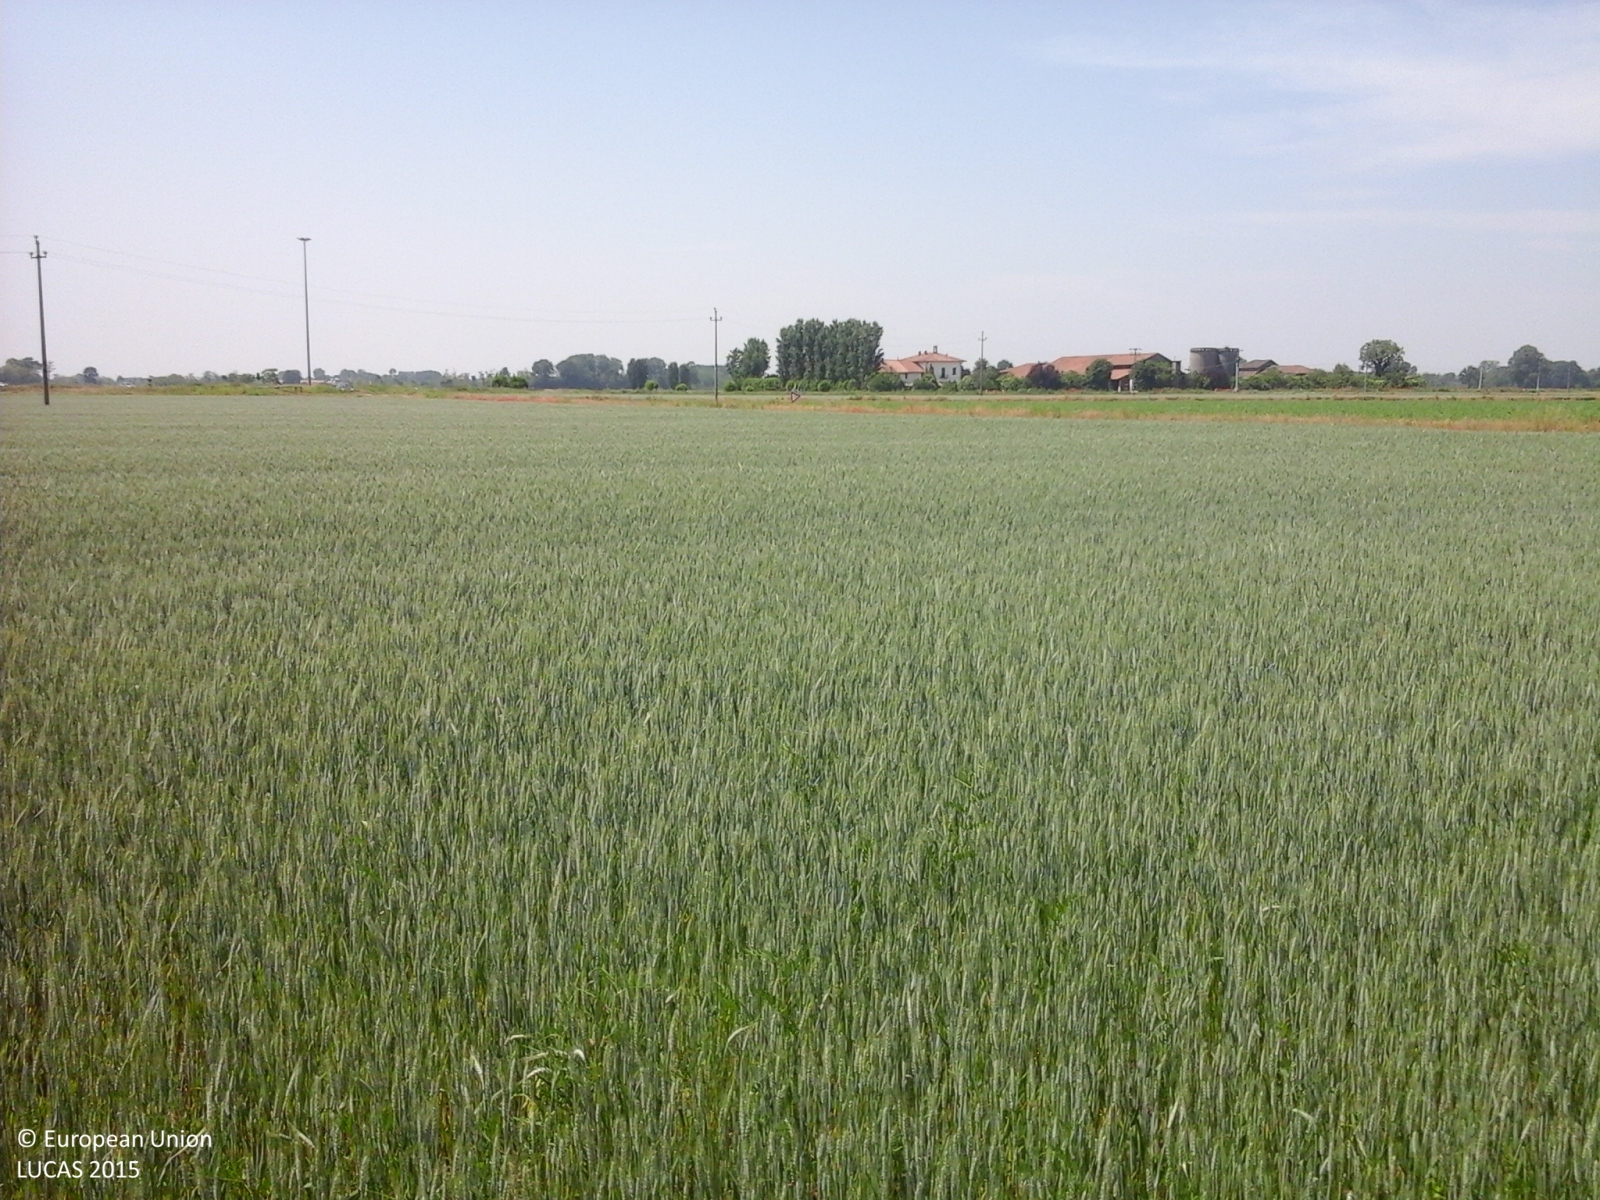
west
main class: Cropland
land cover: Common wheat
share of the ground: > 75 %
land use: Agriculture (excluding fallow land and kitchen gardens)
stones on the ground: 10 - 25 %
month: May
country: IT
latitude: 45.2678
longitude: 9.3003
